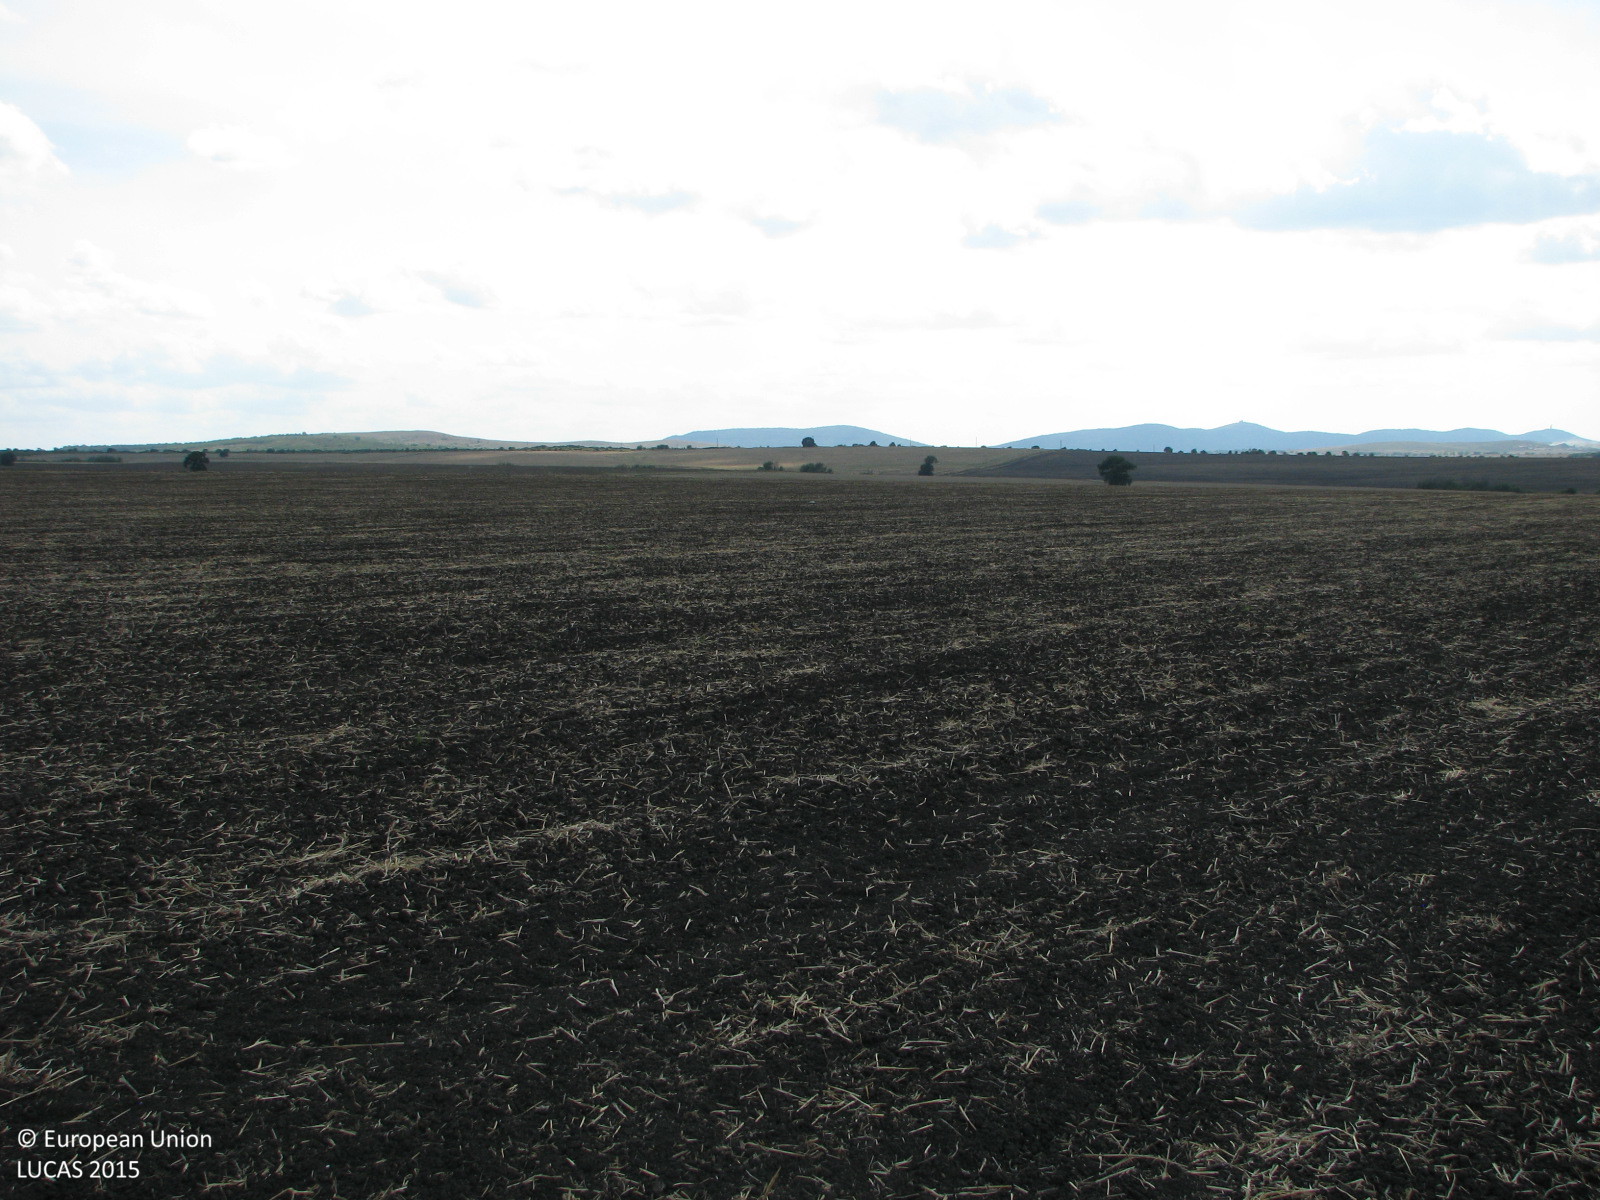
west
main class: Cropland
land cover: Common wheat
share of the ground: < 10 %
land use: Agriculture (excluding fallow land and kitchen gardens)
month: September
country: BG
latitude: 42.5329
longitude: 26.7667
